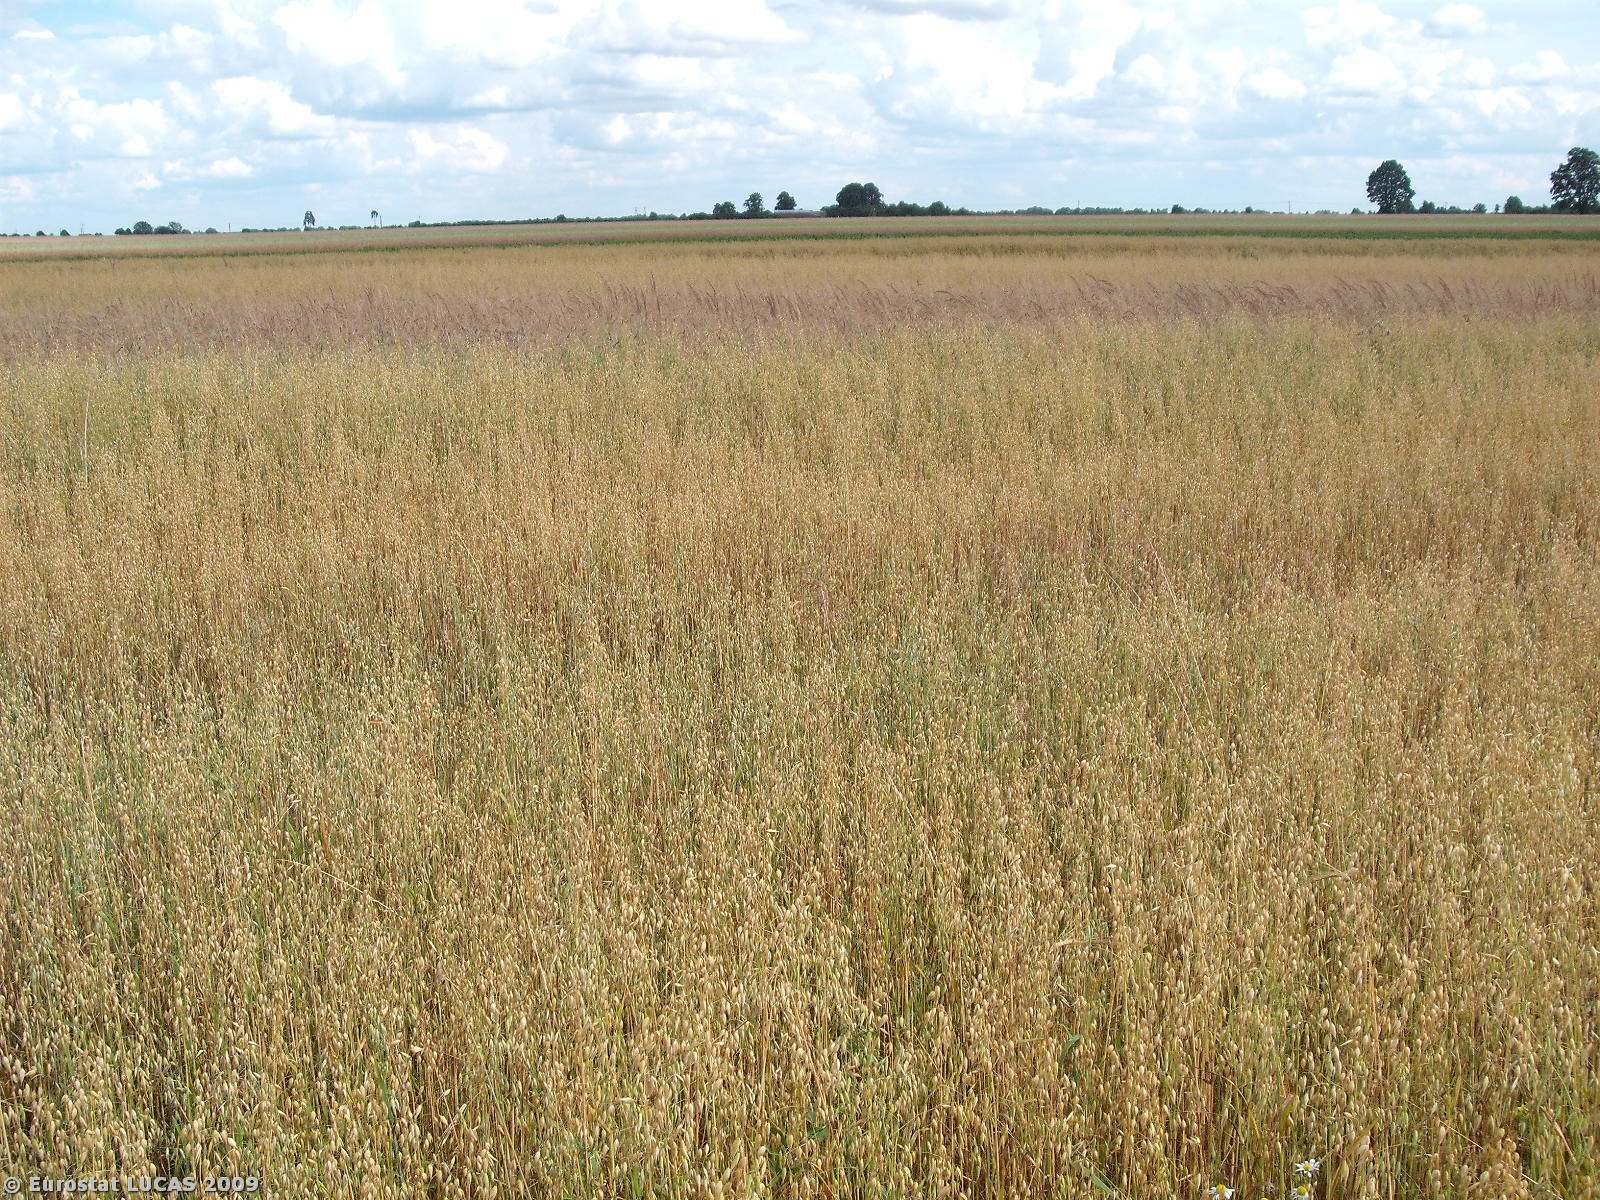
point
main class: Cropland
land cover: Oats
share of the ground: > 75 %
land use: Agriculture (excluding fallow land and kitchen gardens)
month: July
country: PL
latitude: 51.1050
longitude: 21.3461
